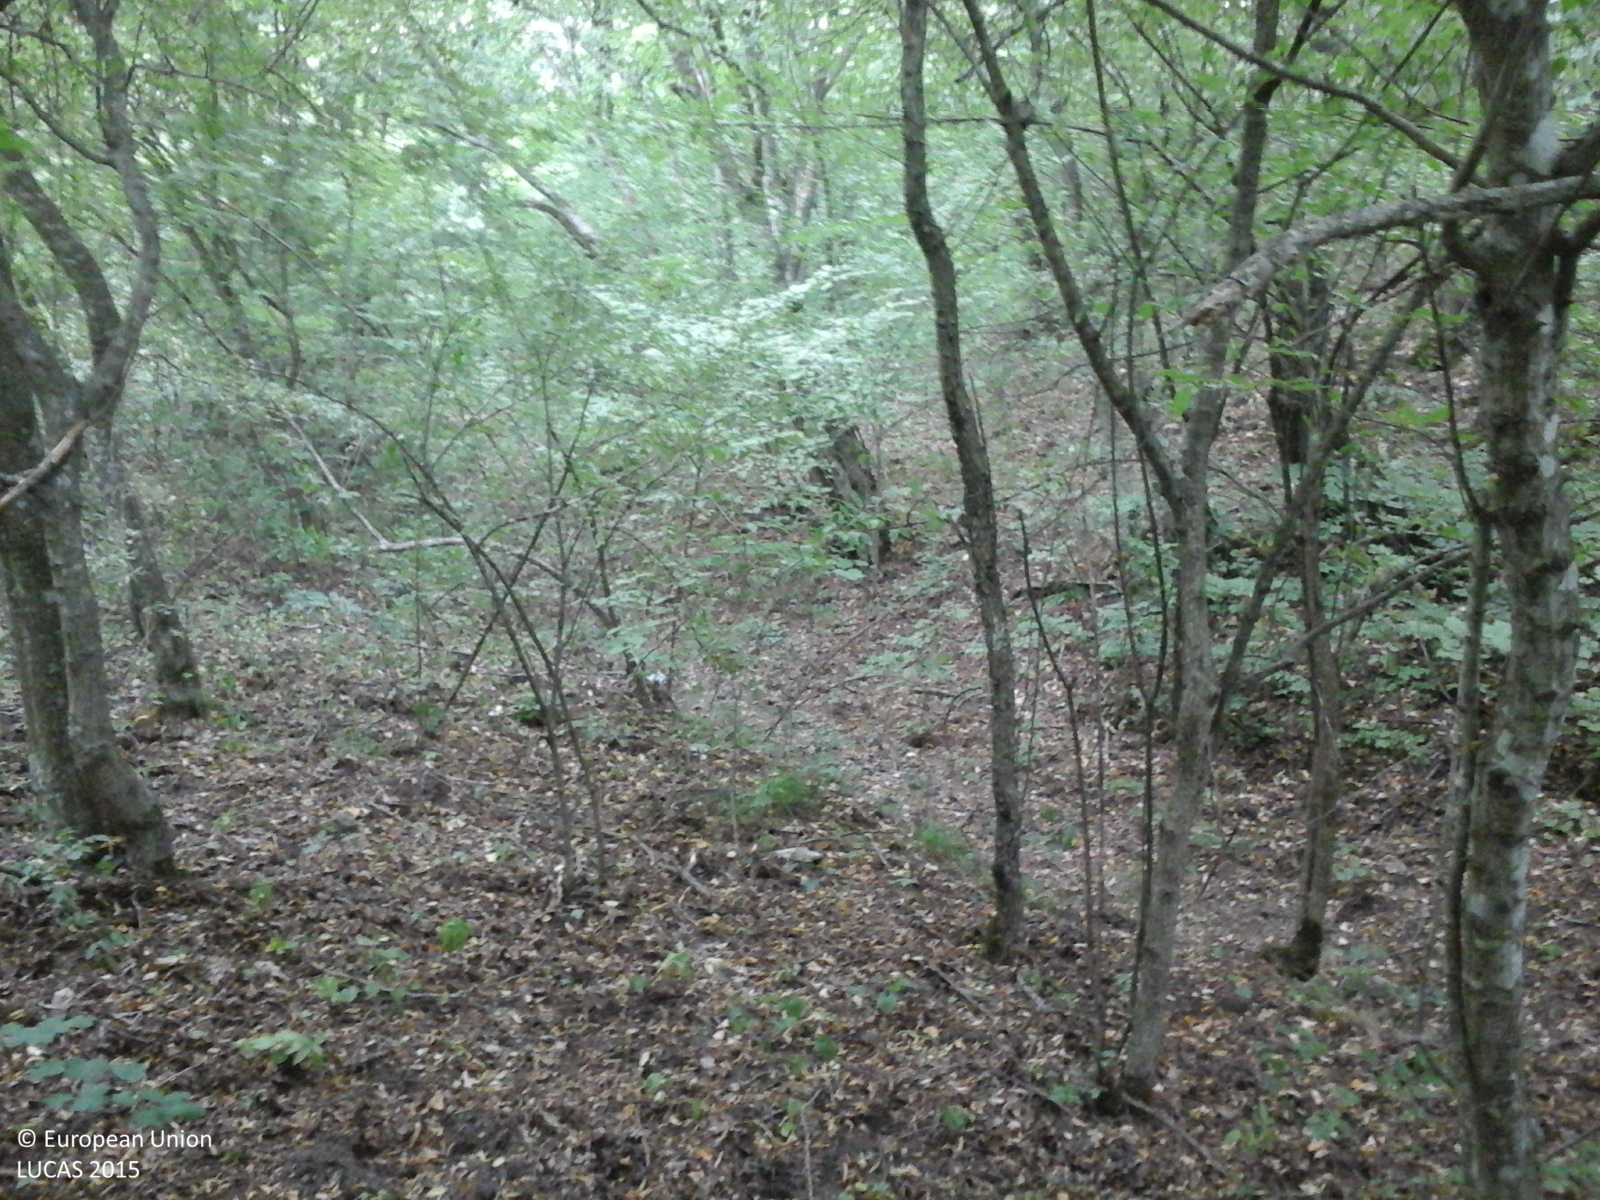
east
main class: Woodland
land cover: Broadleaved woodland
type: beech forest
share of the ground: > 75 %
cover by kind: broadleaved forest trees 100 %
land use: Forestry
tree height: > 5 m
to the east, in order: Broadleaved woodland
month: July
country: RO
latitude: 44.8676
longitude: 28.5969
